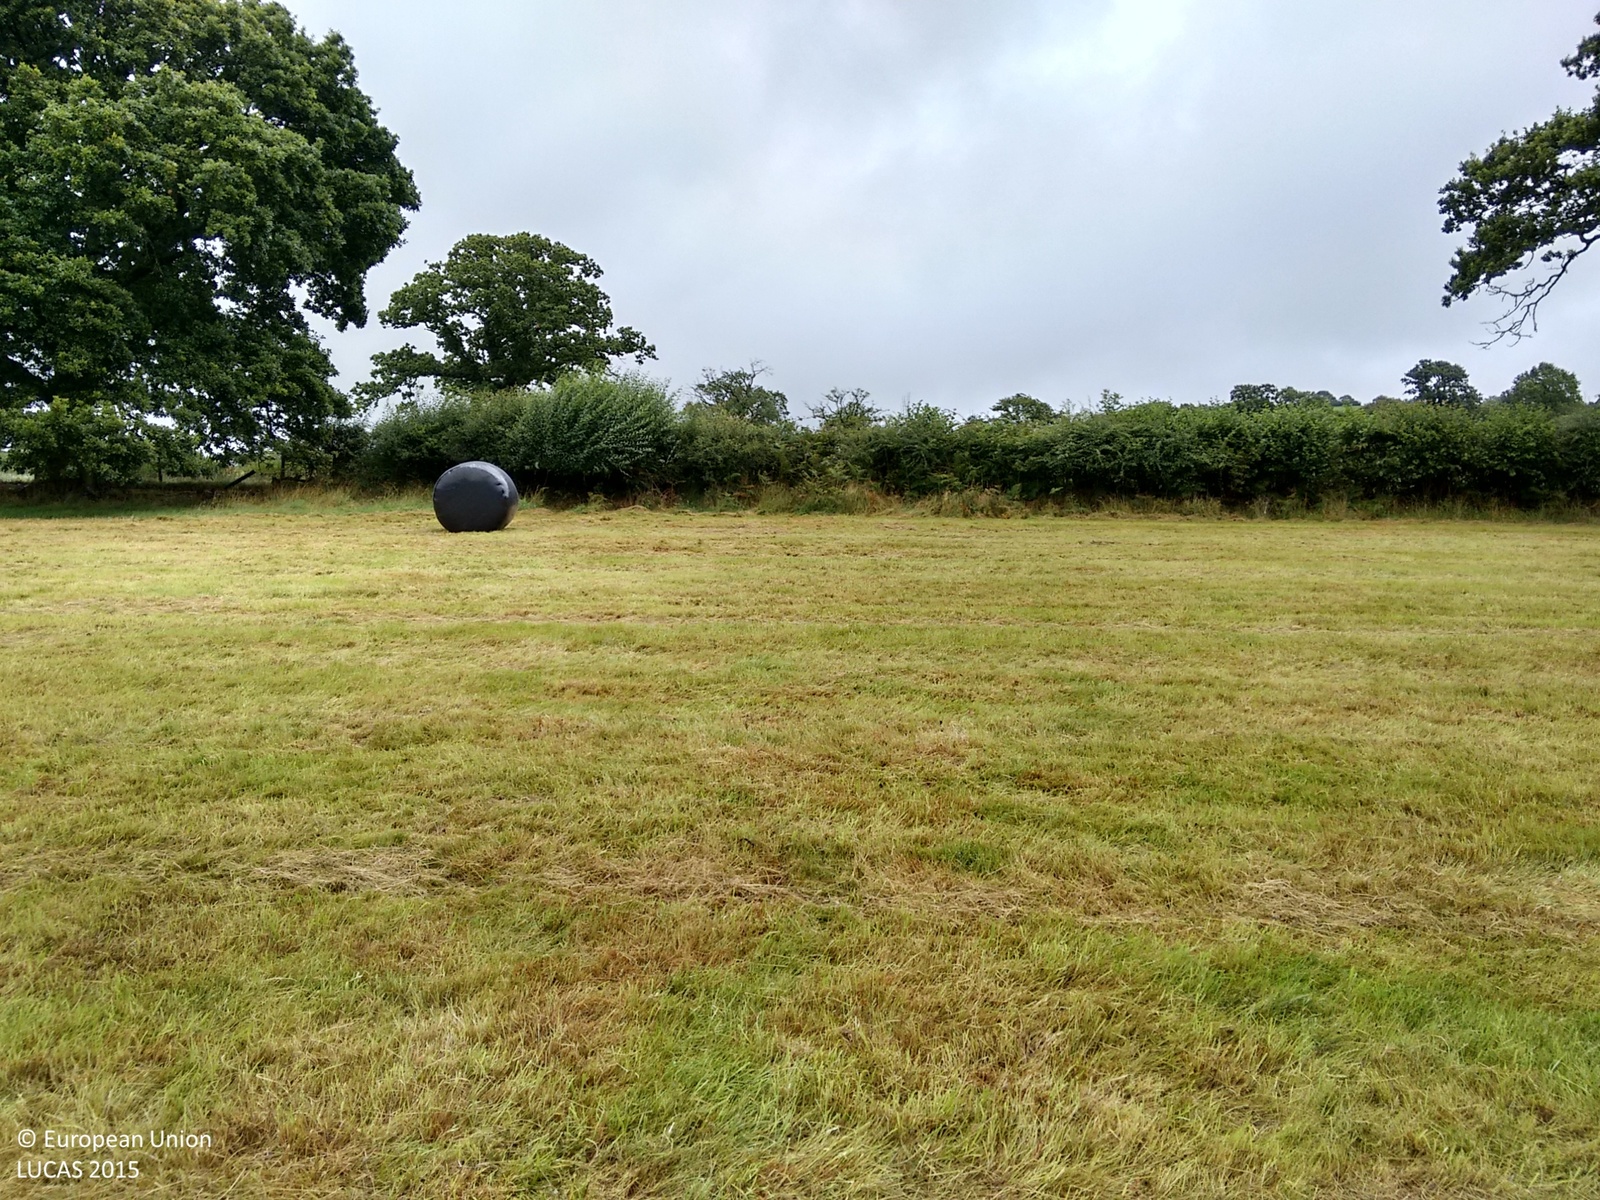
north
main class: Grassland
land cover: Grassland without tree/shrub cover
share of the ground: > 75 %
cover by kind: herbaceous plants 100 %
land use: Agriculture (excluding fallow land and kitchen gardens)
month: August
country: GB
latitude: 51.9034
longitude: -4.0339
